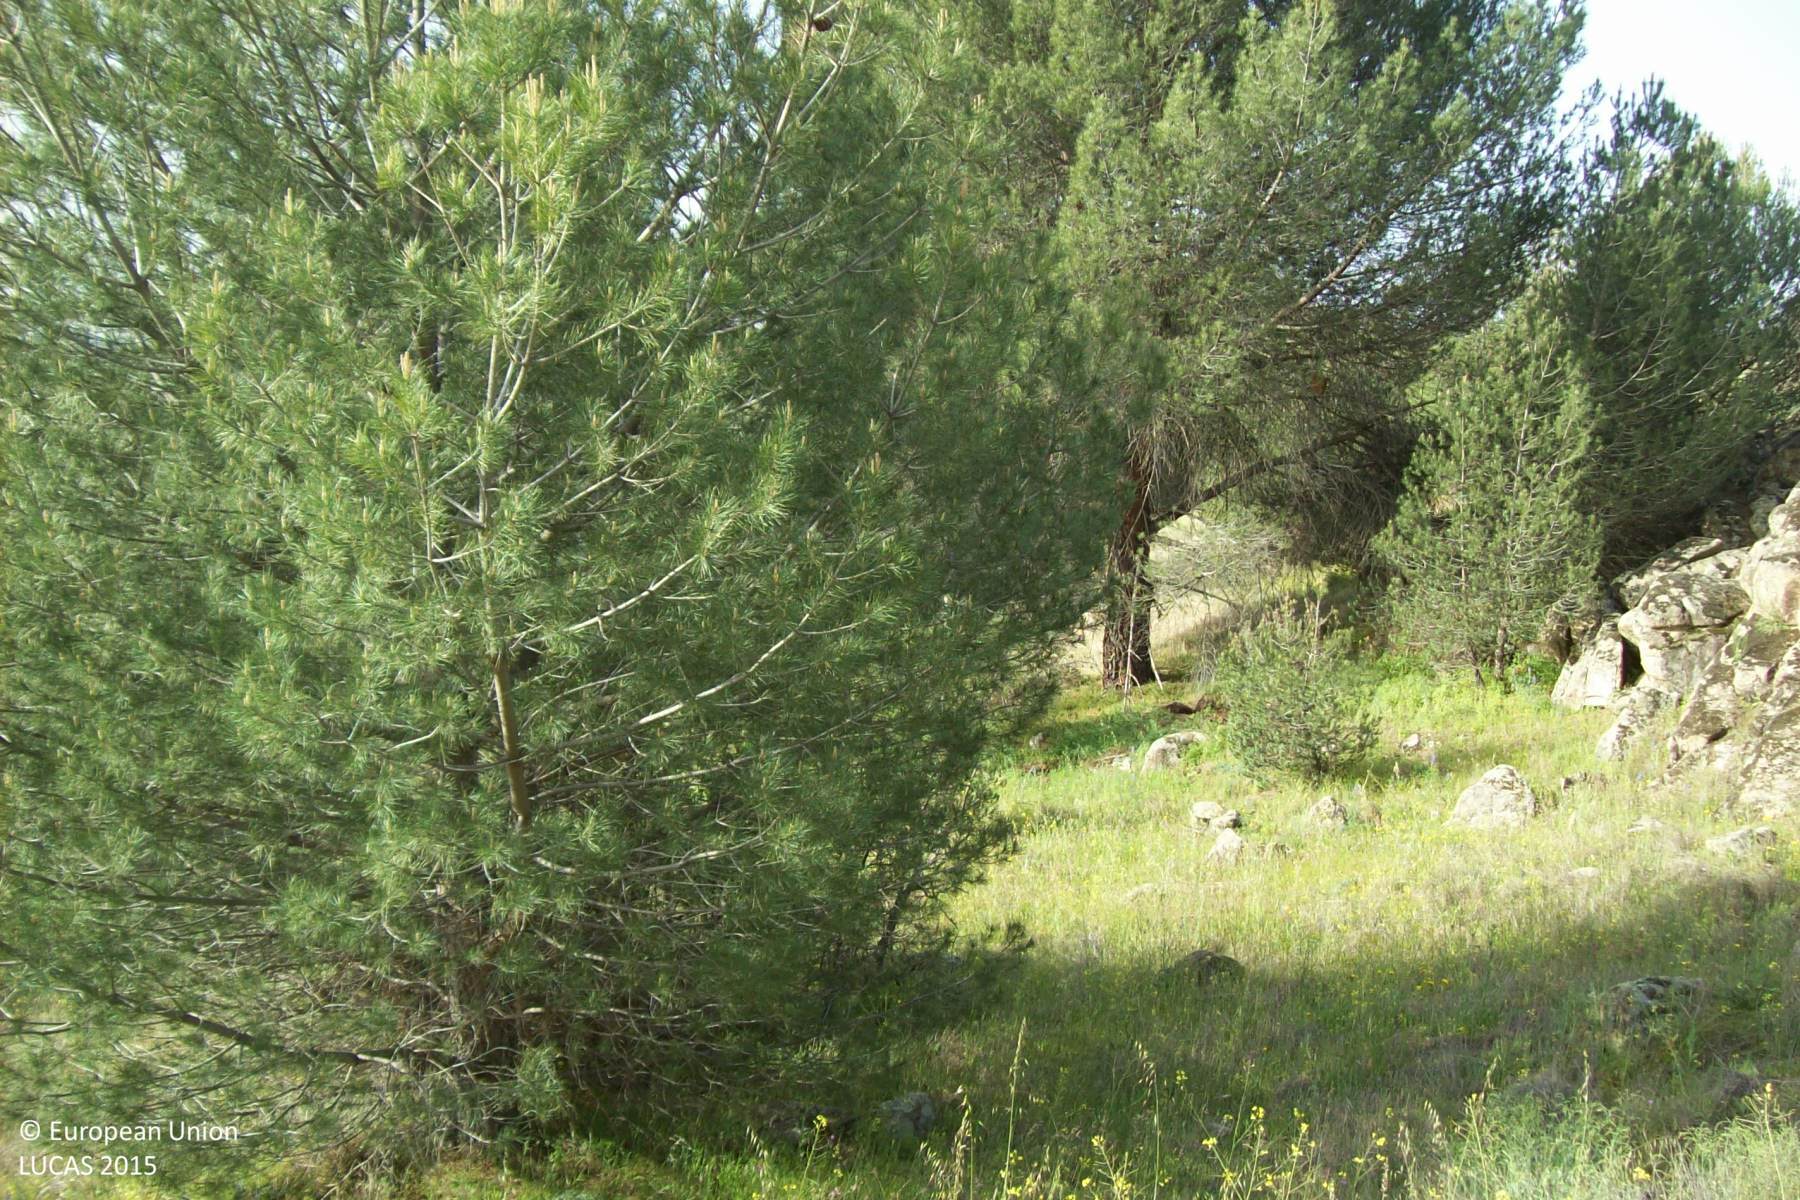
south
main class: Grassland
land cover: Grassland with sparse tree/shrub cover
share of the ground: > 75 %
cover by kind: herbaceous plants 85 %, coniferous forest trees 5 %, shrubs 5 %, consolidated bare surface 5 %
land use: Semi-natural and natural areas not in use
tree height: < 5 m
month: April
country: ES
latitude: 40.5494
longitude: -3.9411
